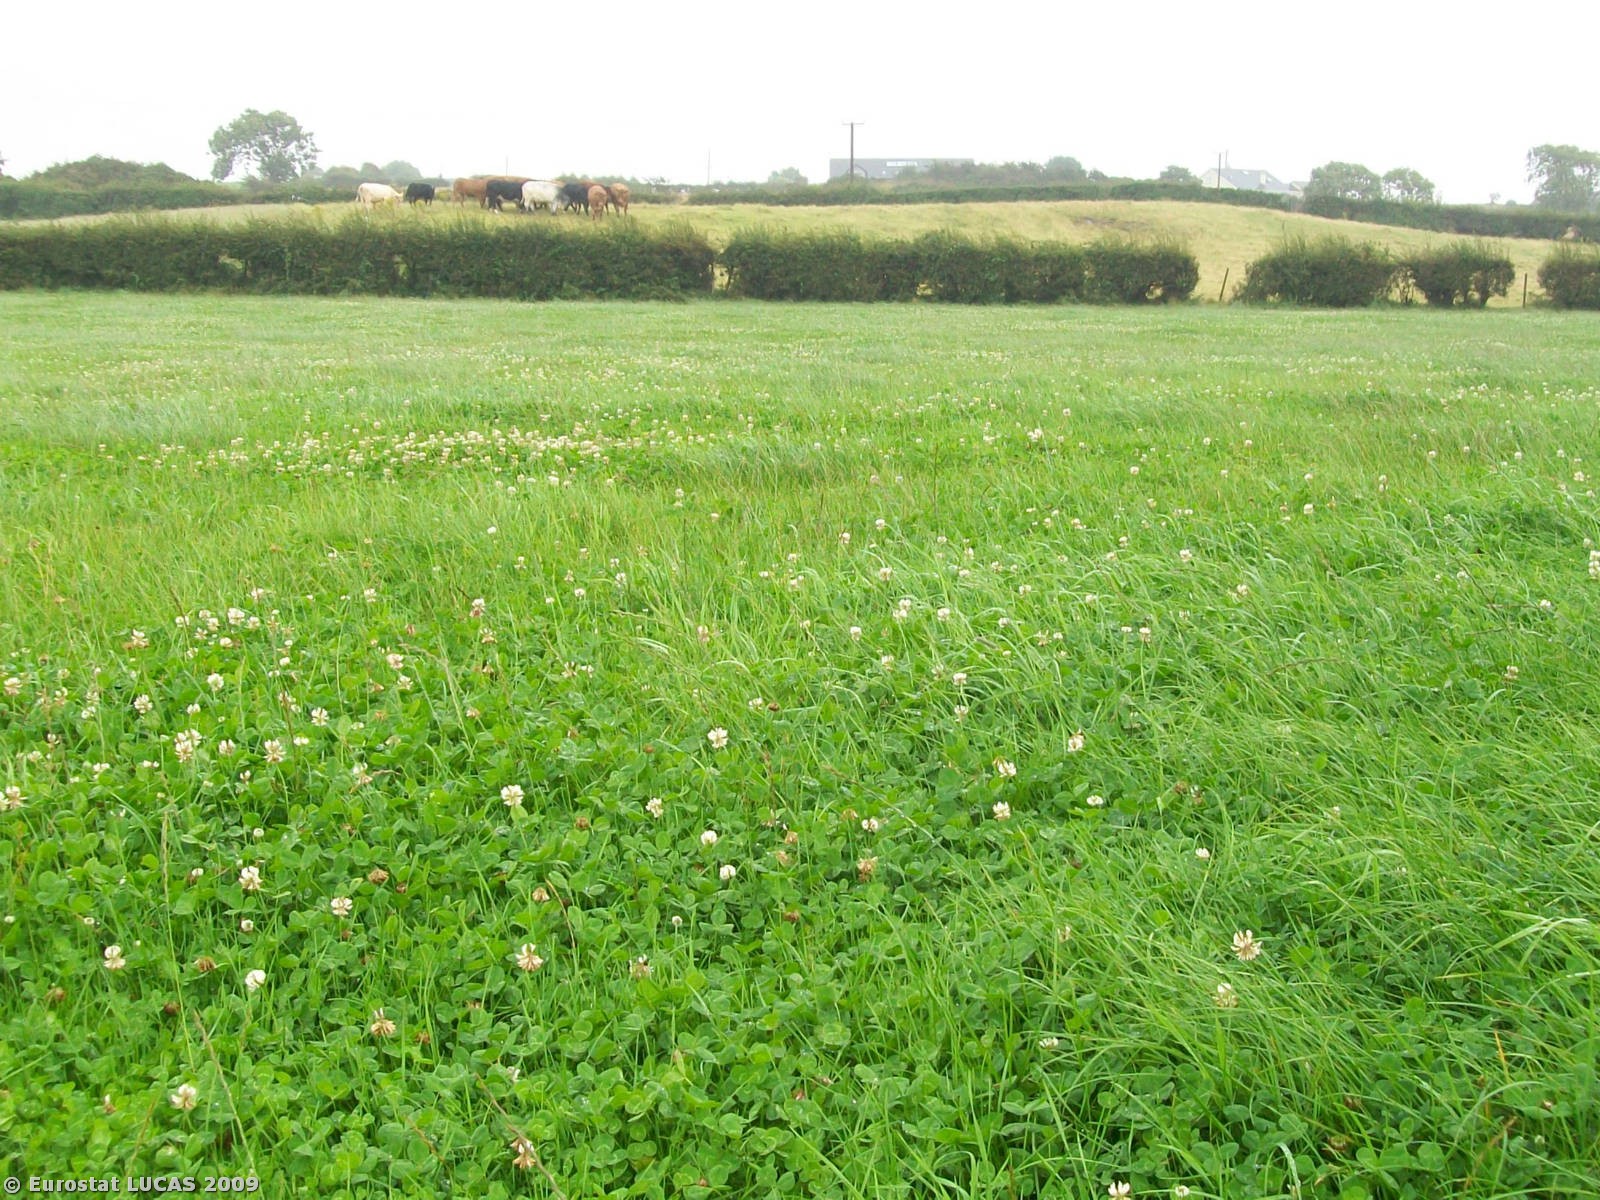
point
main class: Grassland
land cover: Grassland without tree/shrub cover
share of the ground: > 75 %
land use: Agriculture (excluding fallow land and kitchen gardens)
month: August
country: GB
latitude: 54.2852
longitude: -5.6304
